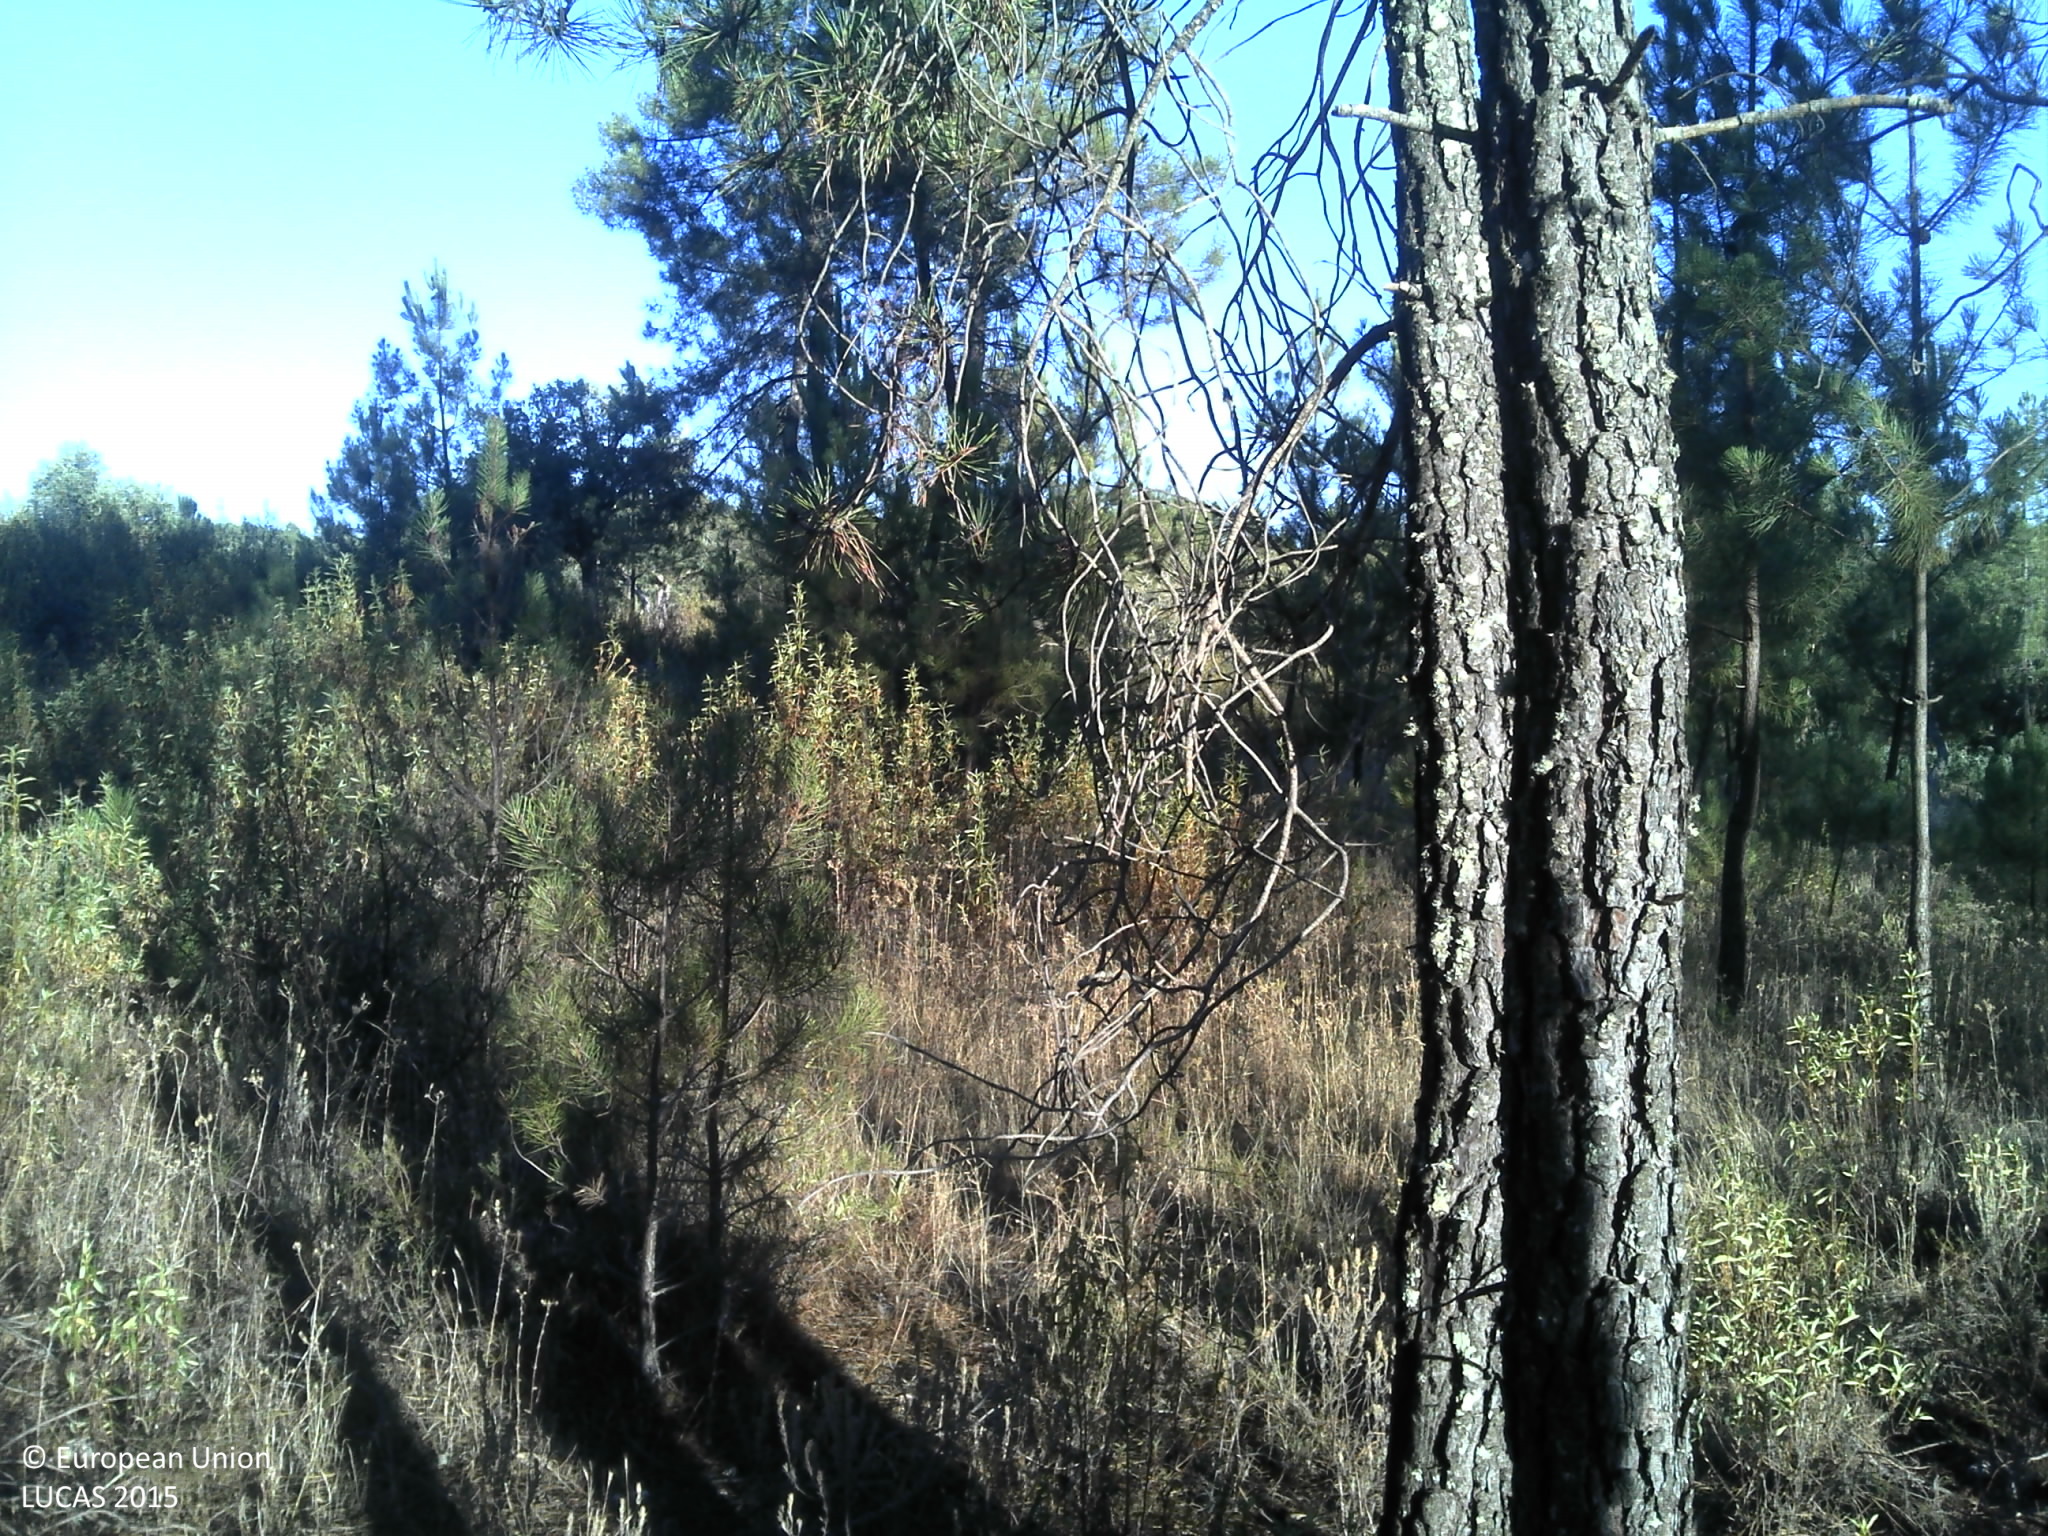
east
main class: Woodland
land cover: Pine dominated coniferous woodland
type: coniferous forest of the mediterranean region
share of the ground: 50 - 75 %
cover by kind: coniferous forest trees 70 %, unconsolidated bare surface 20 %, shrubs 5 %, herbaceous plants 5 %
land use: Forestry
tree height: > 5 m
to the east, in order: Pine dominated coniferous woodland; Shrubland with sparse tree cover; Olive groves; Dry stone walls; Fences; Olive groves; Shrubland with sparse tree cover; Tracks; Olive groves; Grassland without tree/shrub cover; Dry stone walls; Grassland without tree/shrub cover; Fences; Spontaneously vegetated surfaces; Dry stone walls; Olive groves; Fences; Dry stone walls; Rivers and streams; Dry stone walls
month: July
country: PT
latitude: 39.9363
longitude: -7.5987
